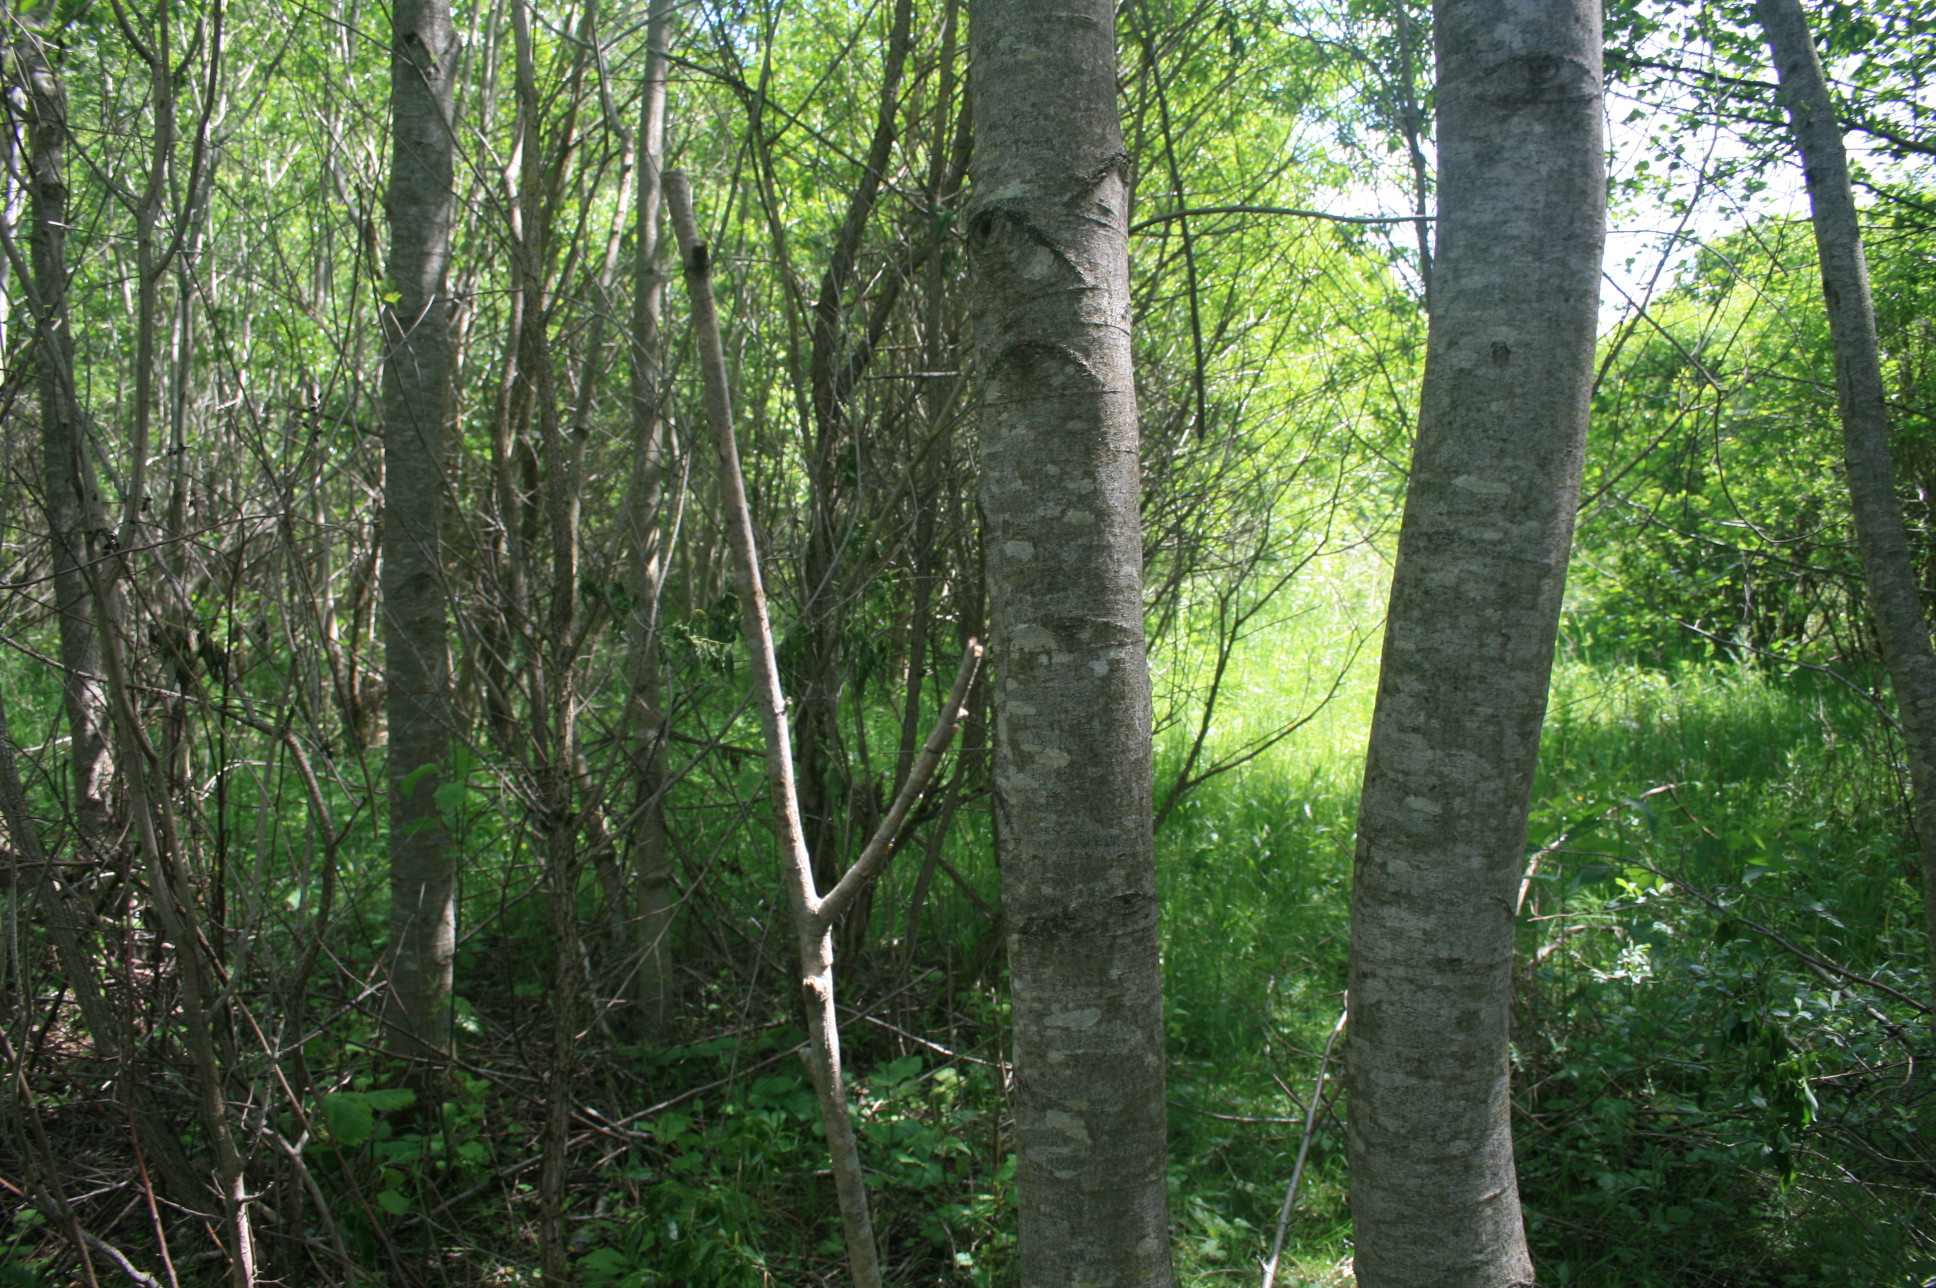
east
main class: Woodland
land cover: Broadleaved woodland
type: non-riverine alder, birch or aspen forest
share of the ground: > 75 %
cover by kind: broadleaved forest trees 95 %, herbaceous plants 5 %
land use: Forestry
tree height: > 5 m
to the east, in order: Broadleaved woodland; Other mixed woodland; Spruce dominated mixed woodland; Electric lines; Abandoned hedges; Common wheat; Grassland without tree/shrub cover
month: June
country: LT
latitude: 56.1509
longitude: 22.3712
